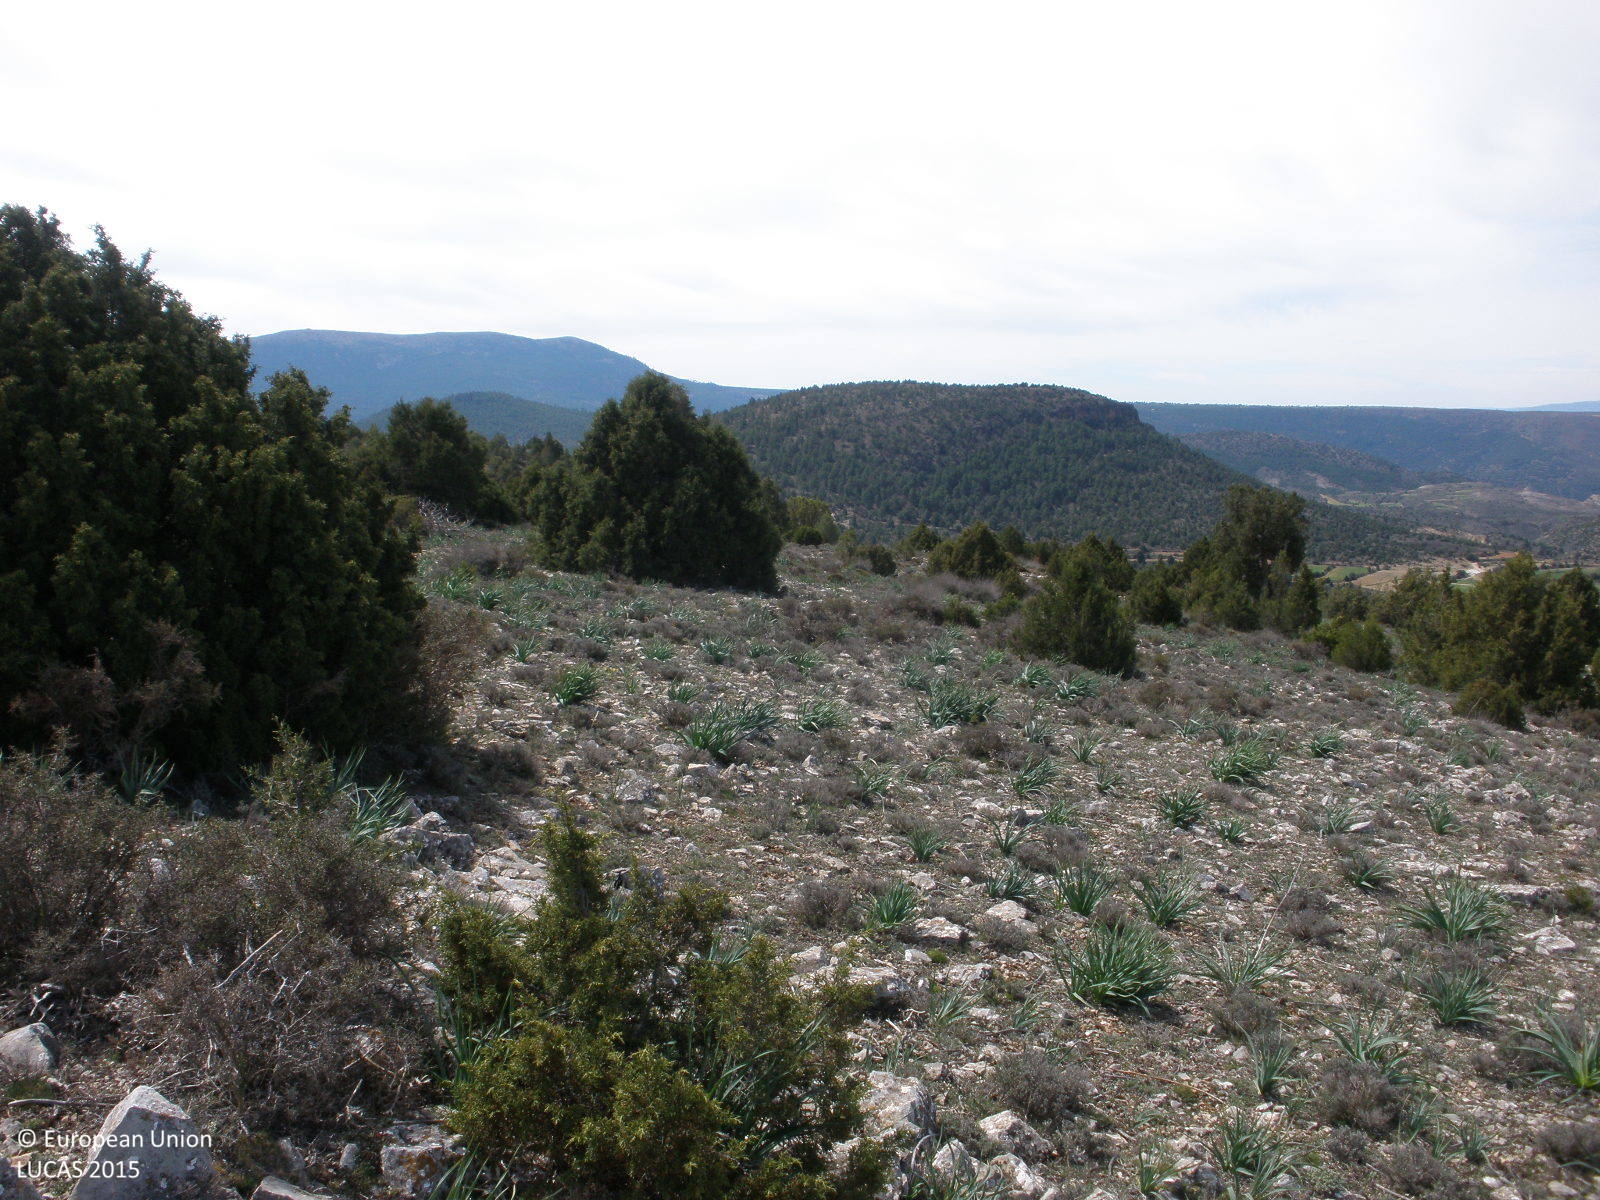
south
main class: Woodland
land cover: Other coniferous woodland
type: coniferous forest of the mediterranean region
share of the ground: 10 - 25 %
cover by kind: consolidated bare surface 45 %, shrubs 20 %, herbaceous plants 20 %, coniferous forest trees 15 %
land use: Semi-natural and natural areas not in use
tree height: < 5 m
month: April
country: ES
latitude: 40.2256
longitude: -1.0441
